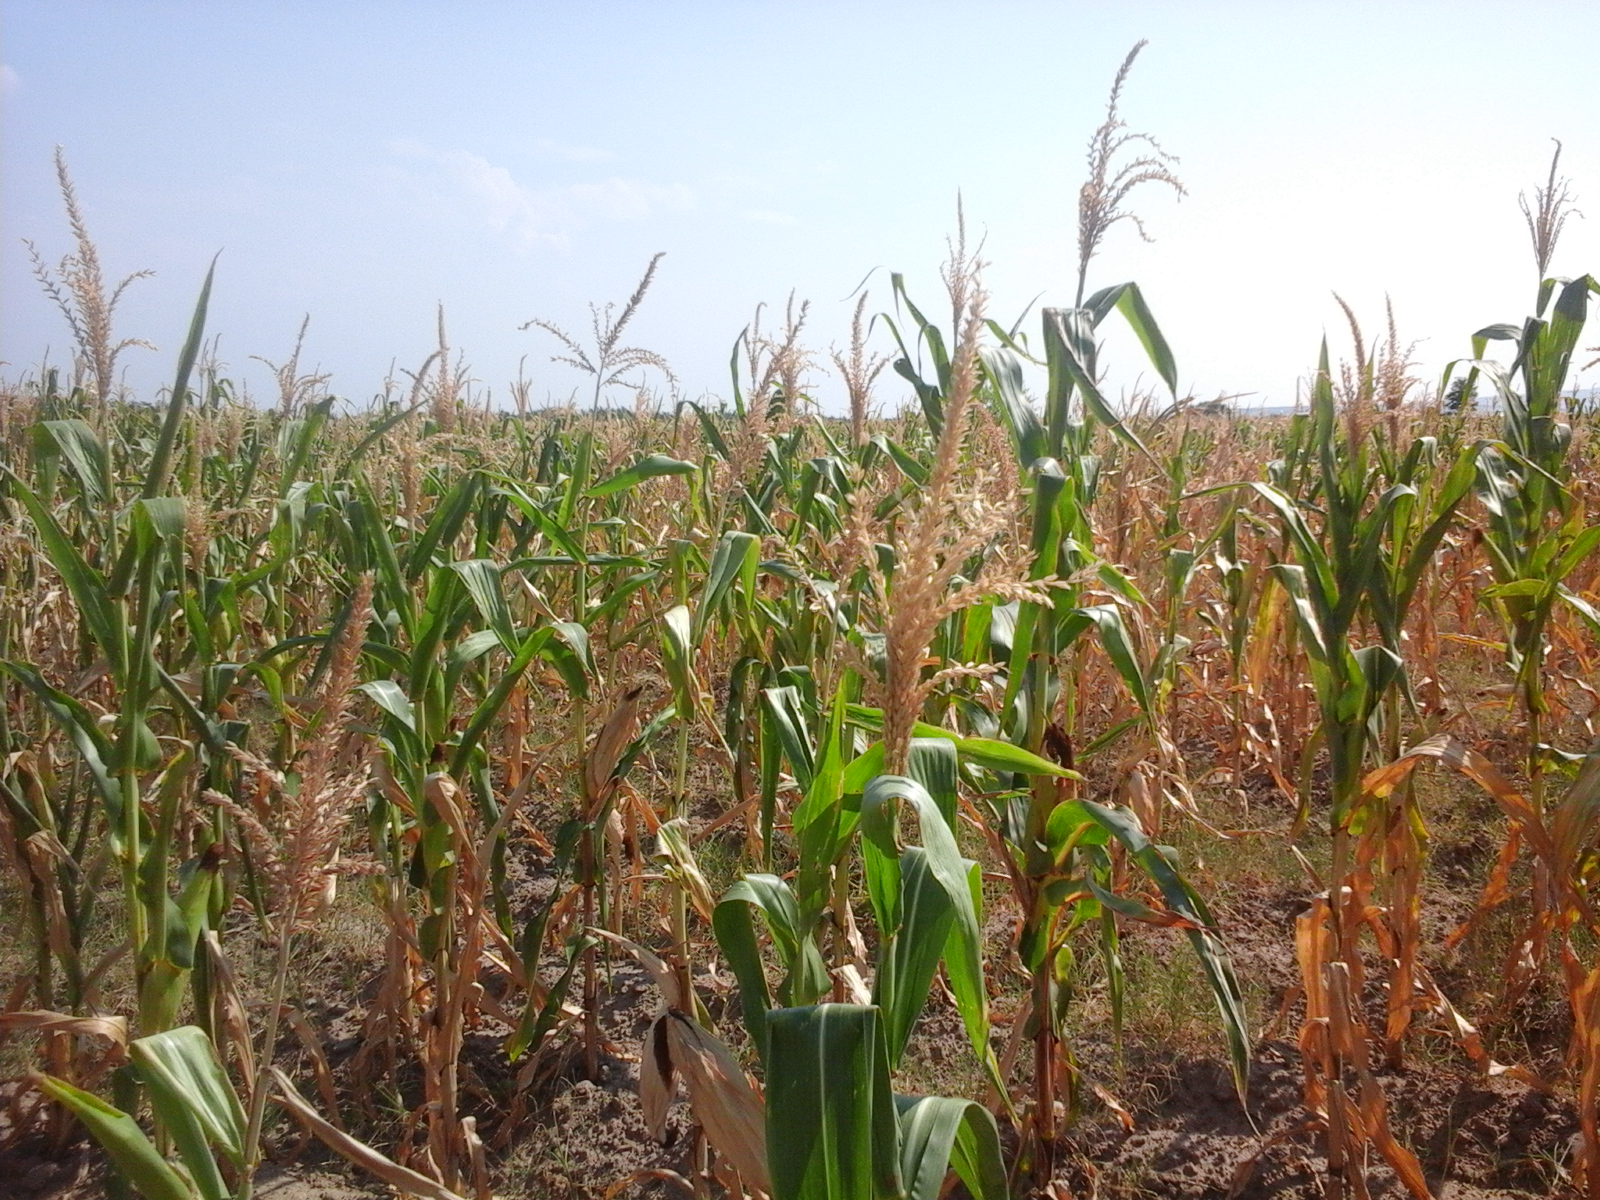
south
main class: Cropland
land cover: Maize
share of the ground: > 75 %
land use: Agriculture (excluding fallow land and kitchen gardens)
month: August
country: RO
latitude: 44.4672
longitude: 22.4948
